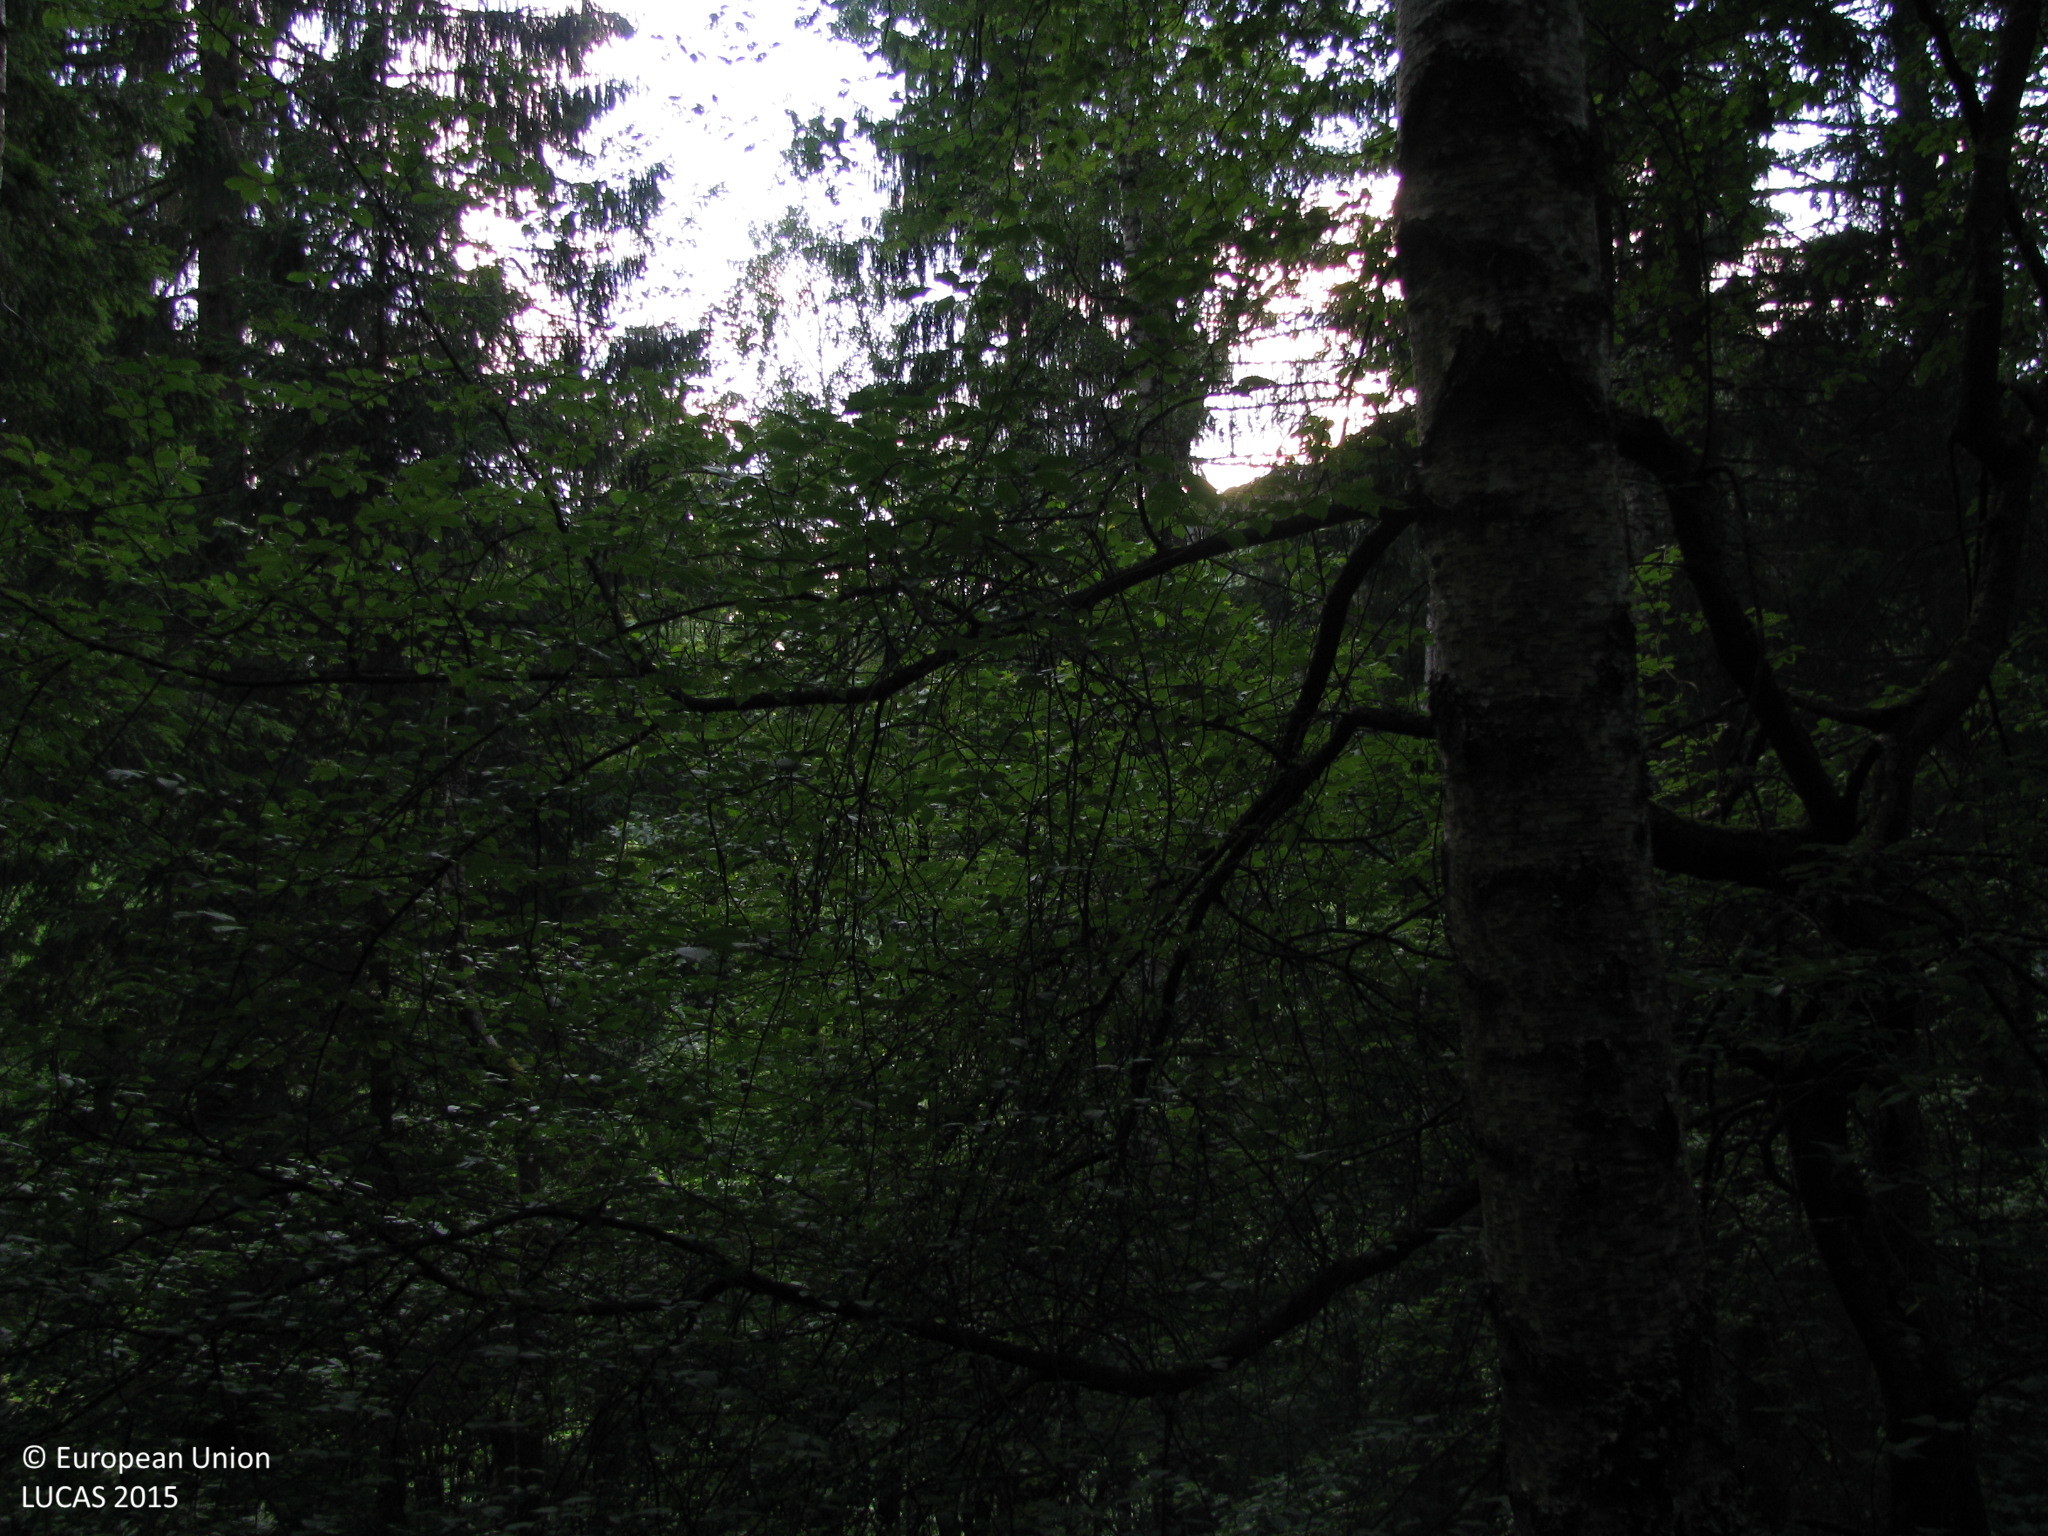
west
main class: Woodland
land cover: Spruce dominated mixed woodland
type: mire and swamp forests
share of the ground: 50 - 75 %
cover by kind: coniferous forest trees 35 %, broadleaved forest trees 35 %, herbaceous plants 30 %
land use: Forestry
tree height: > 5 m
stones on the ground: < 10 %
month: June
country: AT
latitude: 47.2427
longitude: 14.6359
